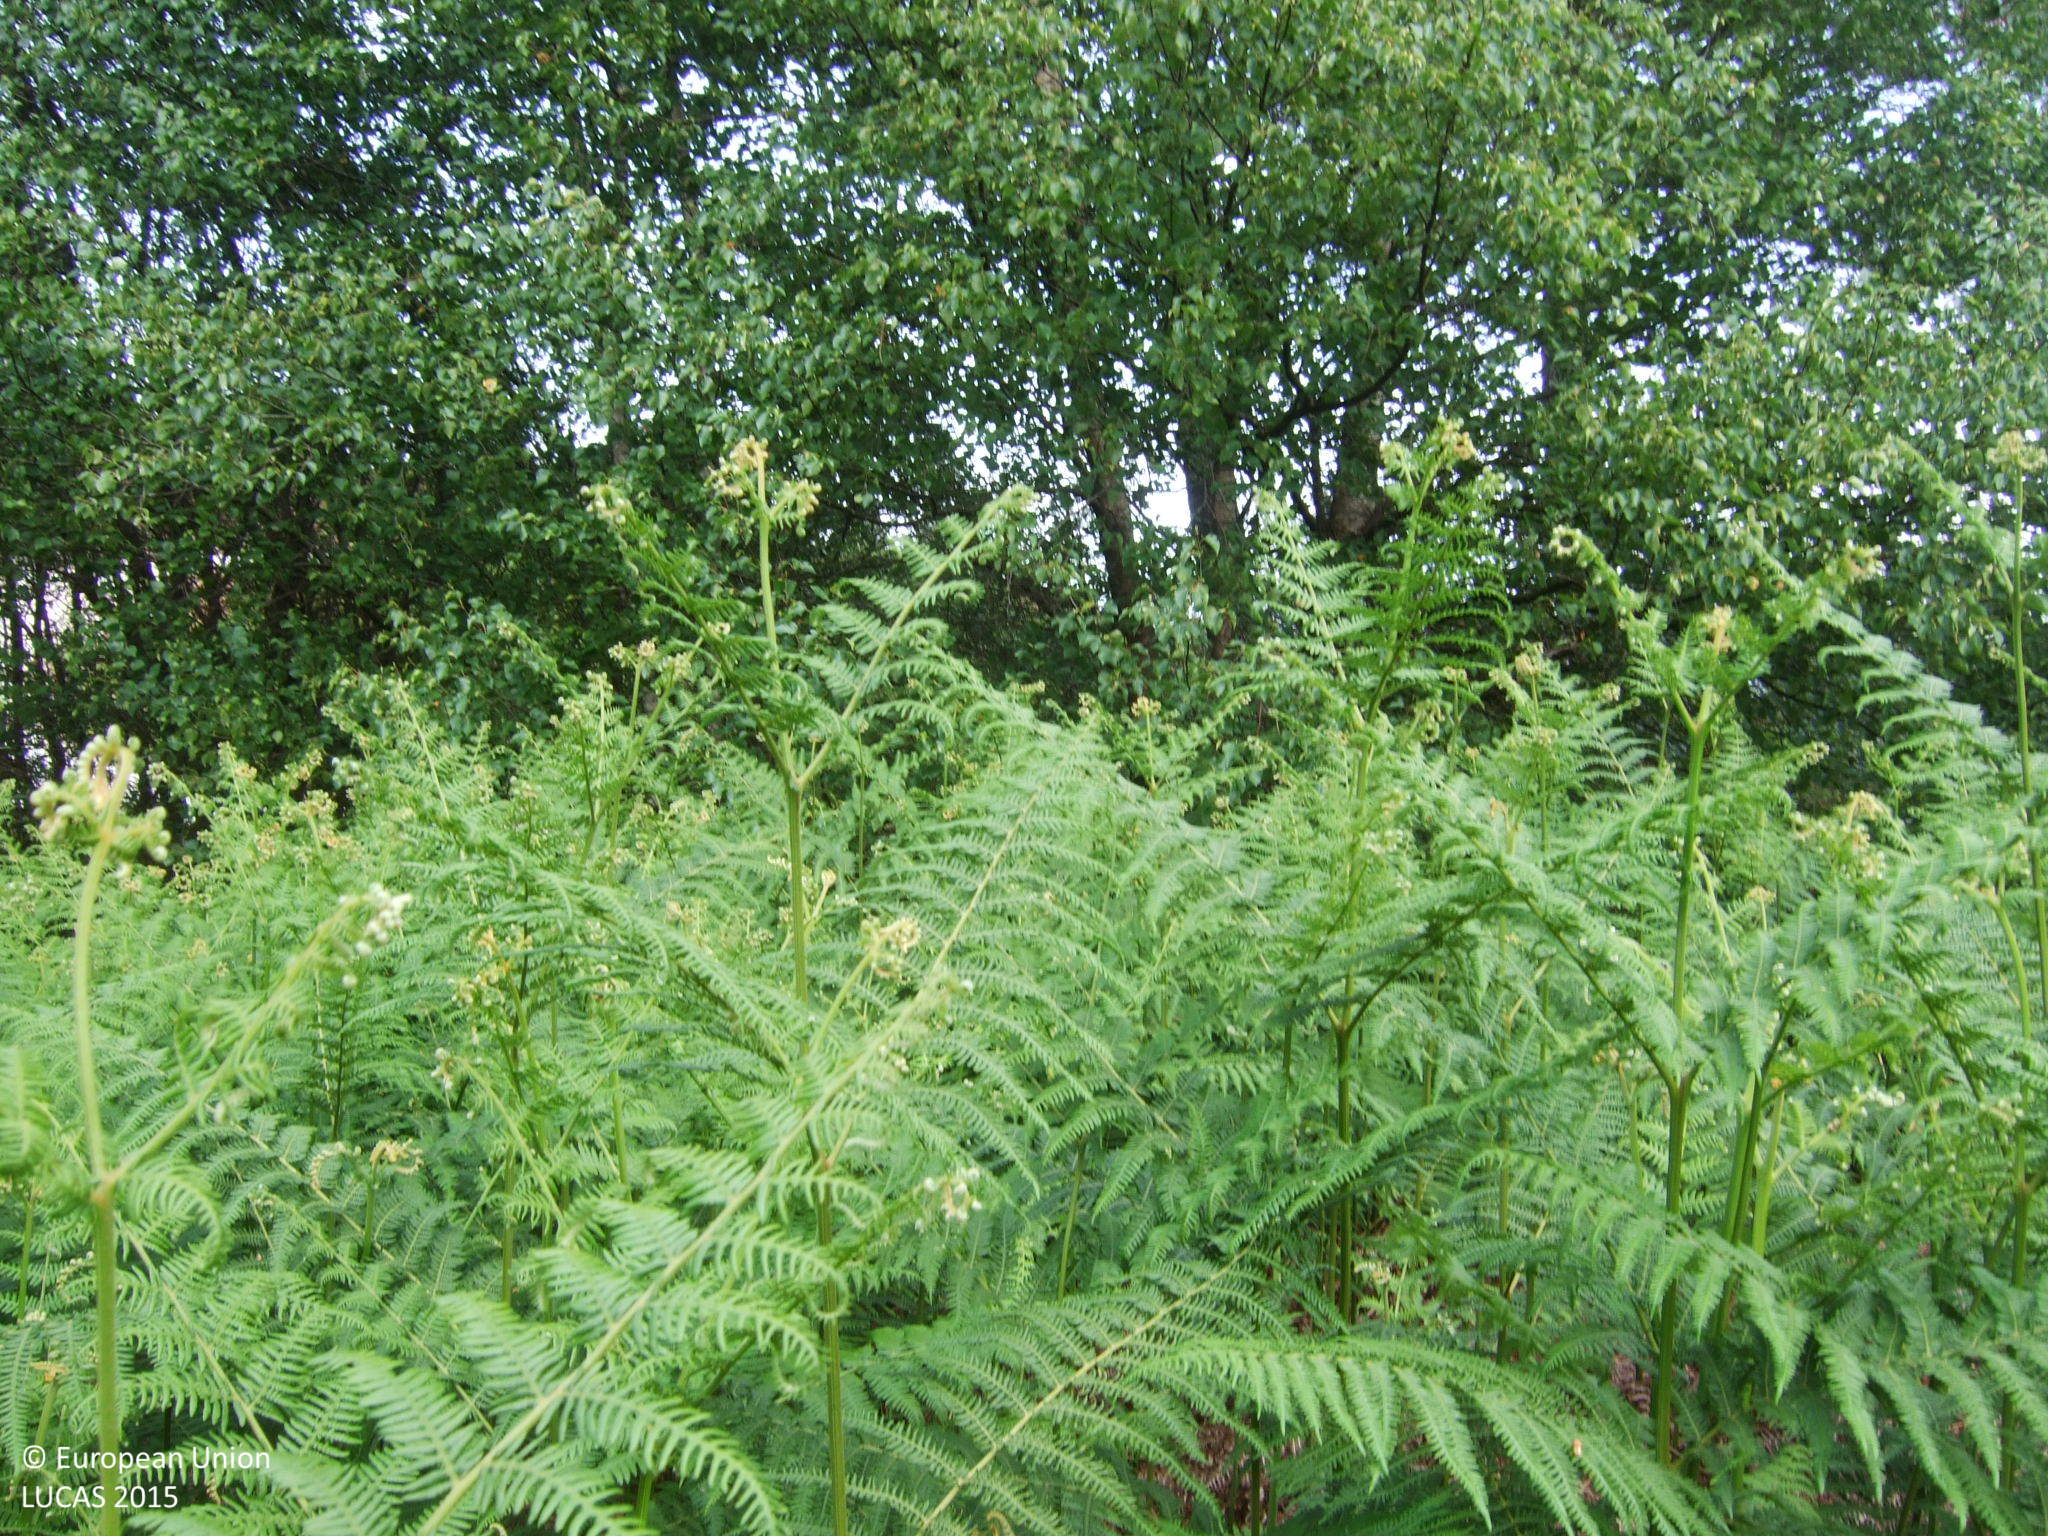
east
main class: Woodland
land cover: Broadleaved woodland
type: acidophilous oak and oak-birch forest
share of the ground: 10 - 25 %
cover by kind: shrubs 75 %, broadleaved forest trees 25 %
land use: Forestry
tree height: > 5 m
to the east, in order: Broadleaved woodland; Tracks; Shrubland without tree cover; Broadleaved woodland; Rivers and streams; Tracks; Broadleaved woodland
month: June
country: ES
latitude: 43.3636
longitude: -7.7197
